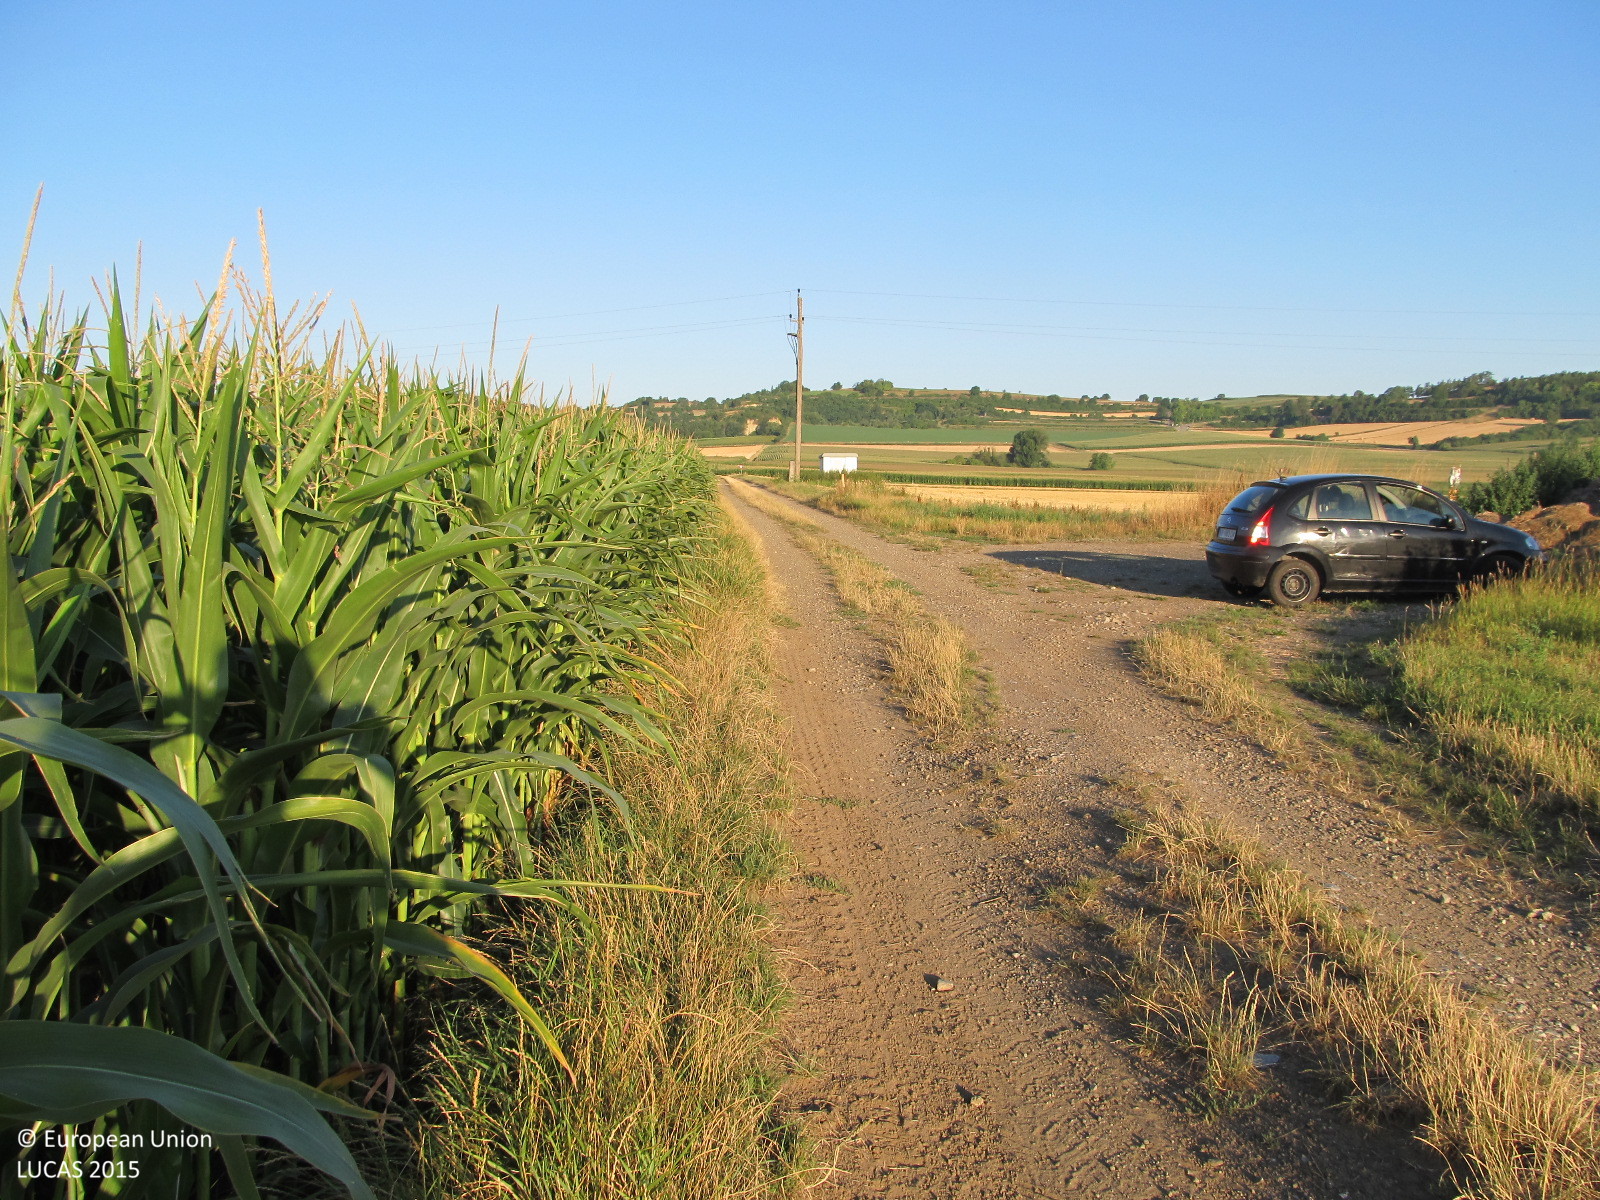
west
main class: Cropland
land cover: Maize
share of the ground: > 75 %
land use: Agriculture (excluding fallow land and kitchen gardens)
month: July
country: AT
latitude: 48.2785
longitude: 15.6219
